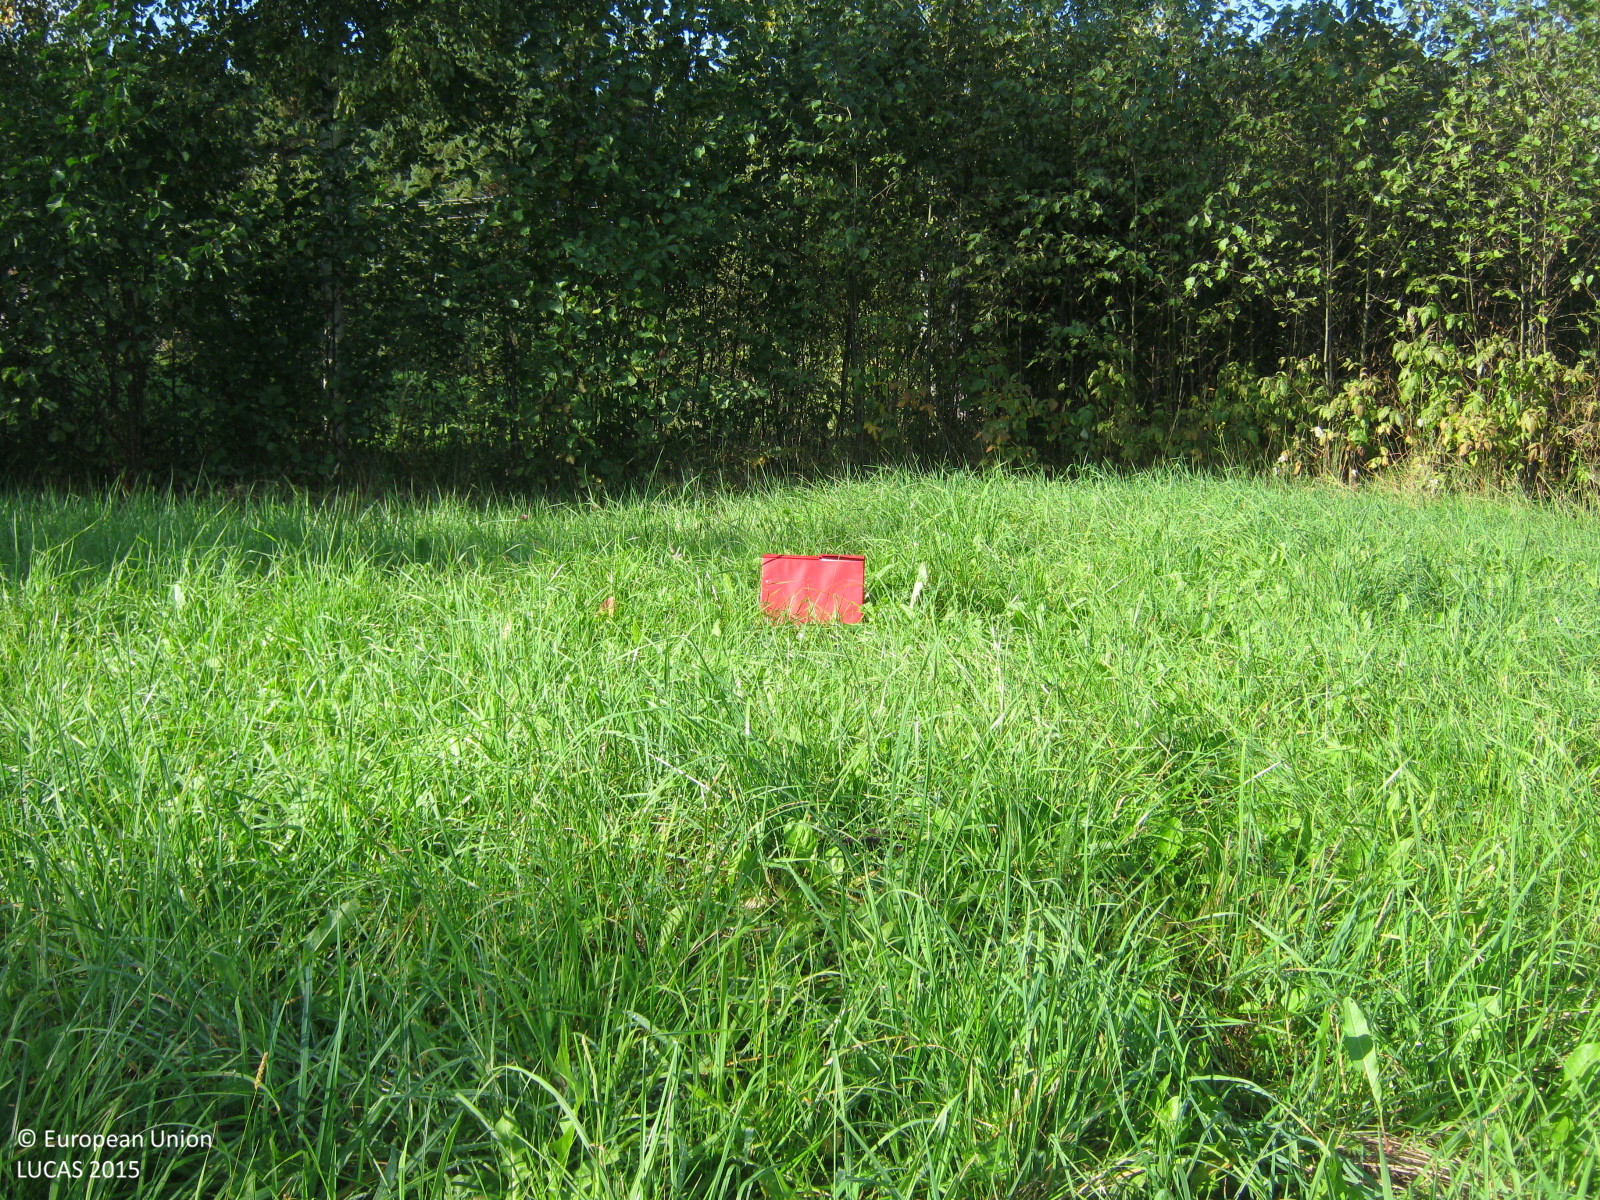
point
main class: Grassland
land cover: Grassland without tree/shrub cover
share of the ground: > 75 %
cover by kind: herbaceous plants 100 %
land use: Agriculture (excluding fallow land and kitchen gardens)
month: September
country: LV
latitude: 57.3644
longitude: 24.4043
